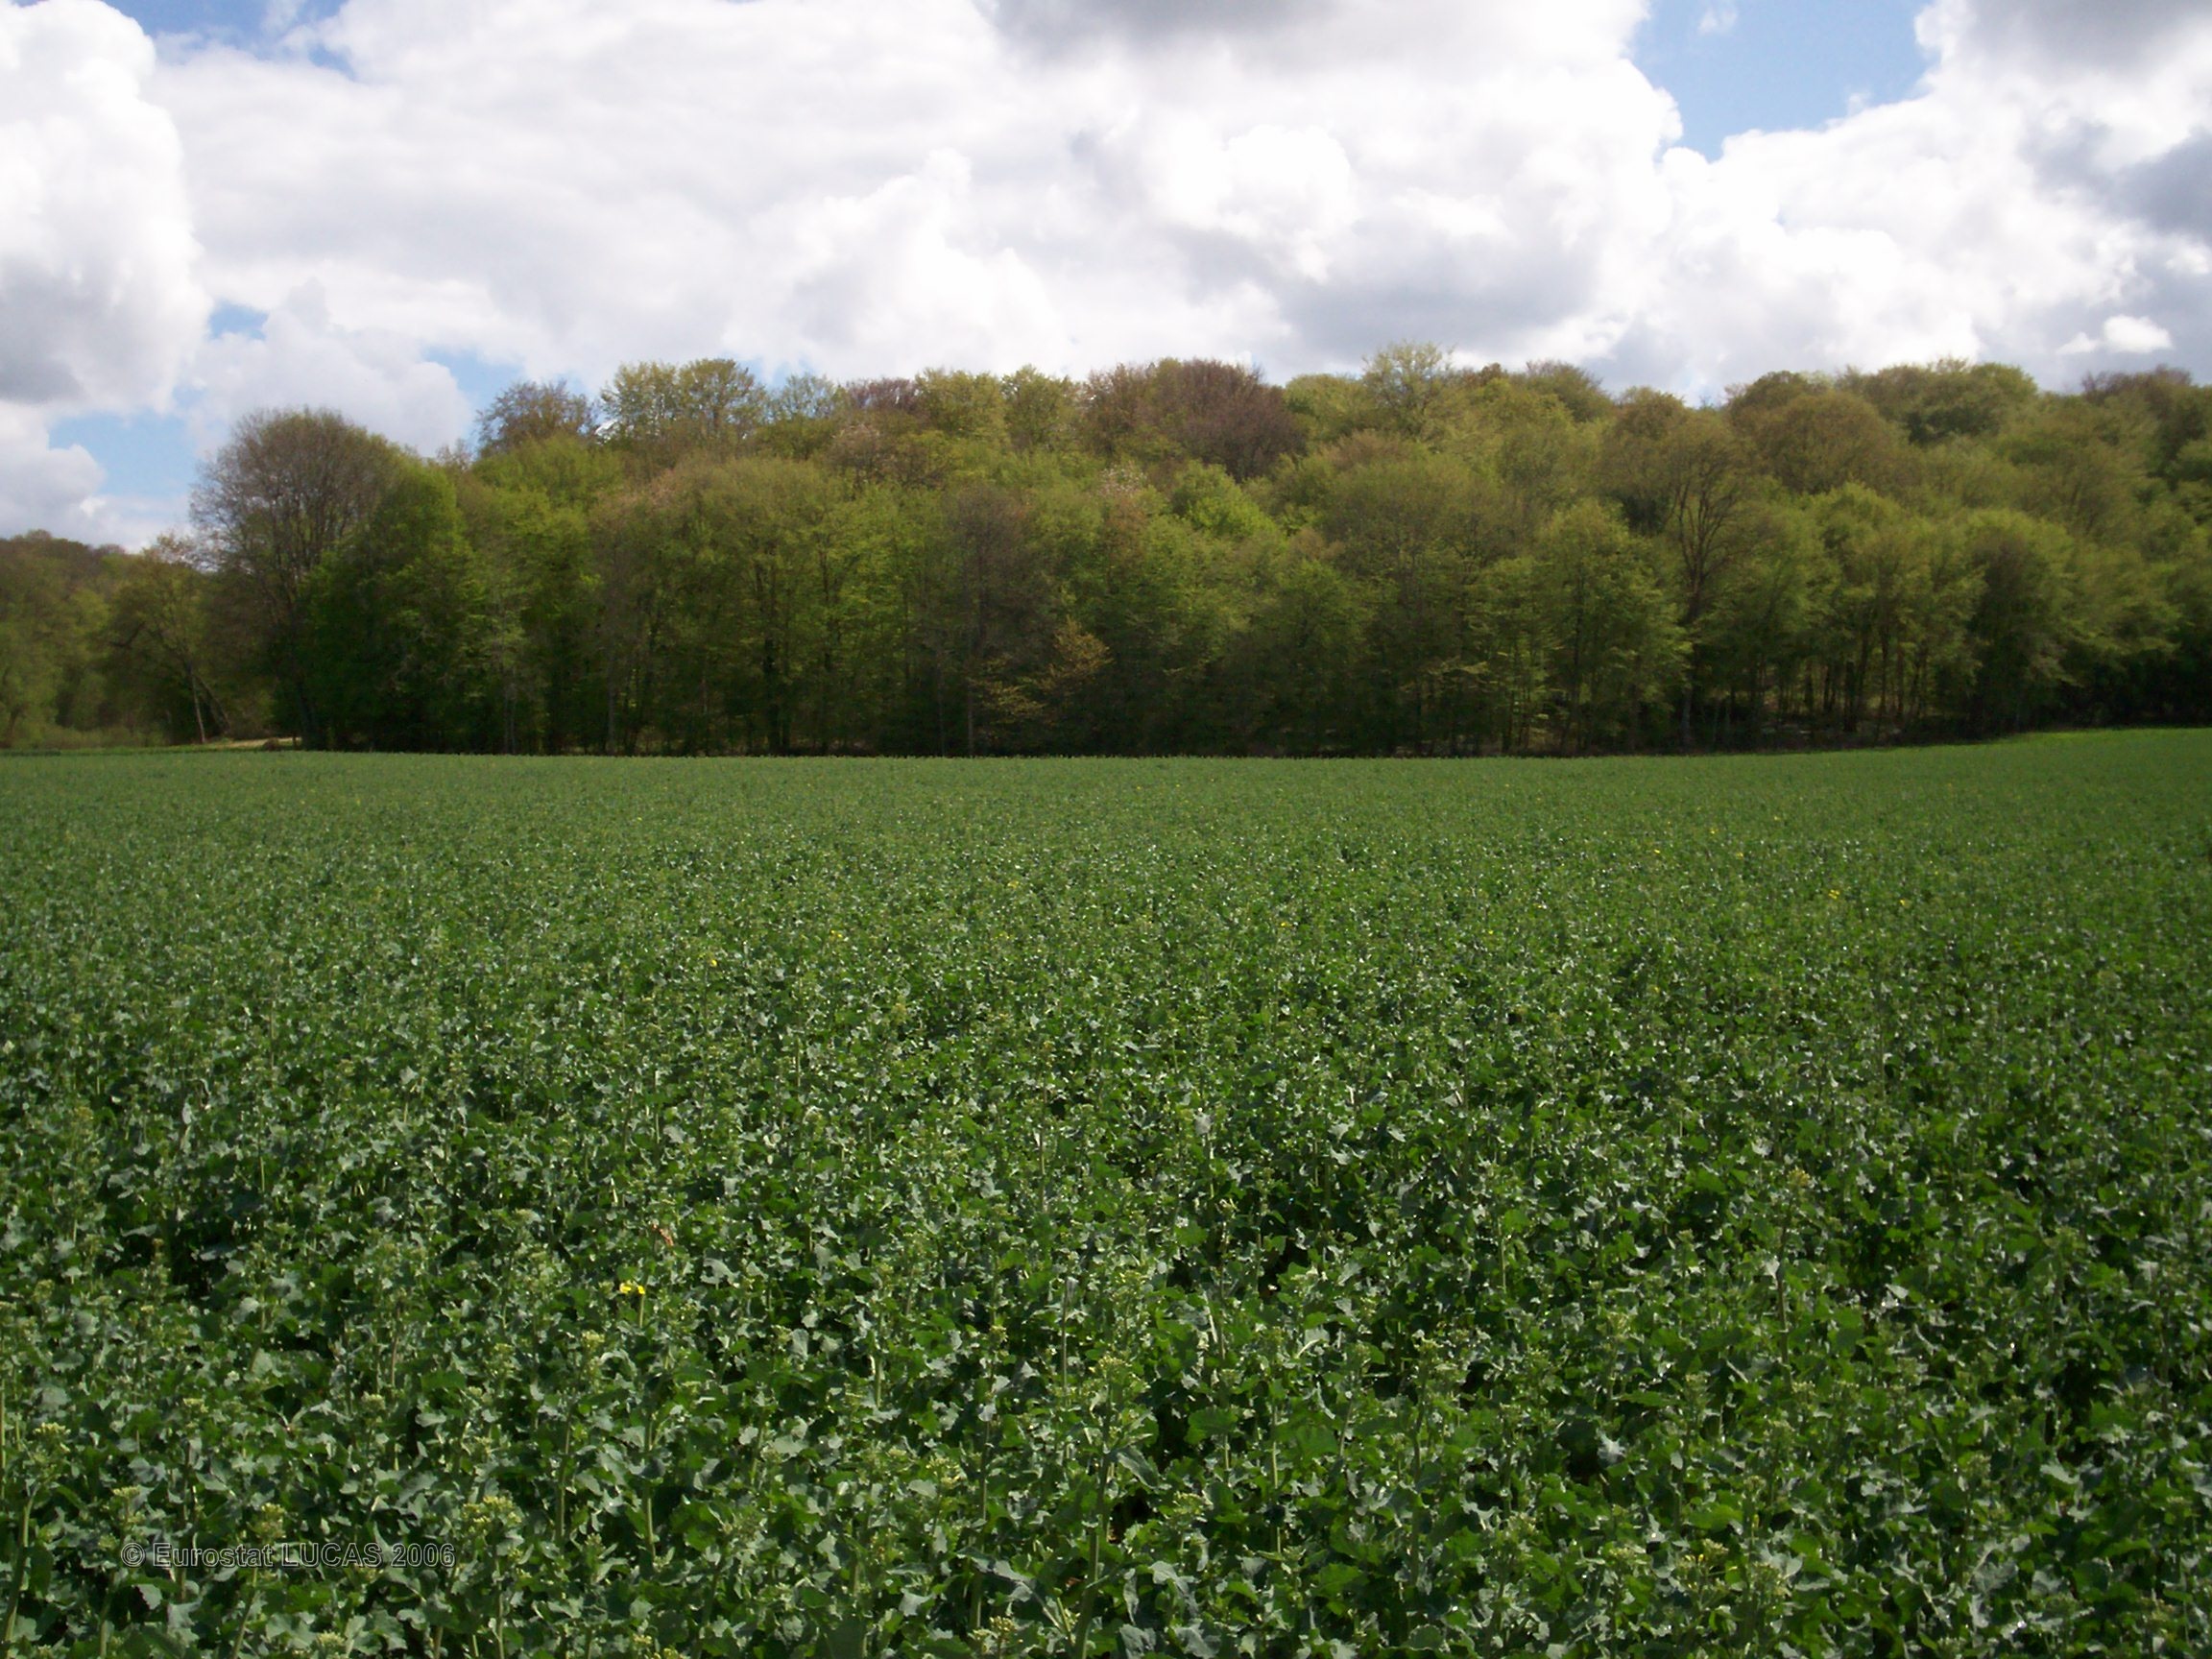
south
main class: Cropland
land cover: Rape and turnip rape
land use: Agriculture (excluding fallow land and kitchen gardens)
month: April
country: FR
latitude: 47.5413
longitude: 6.0821
